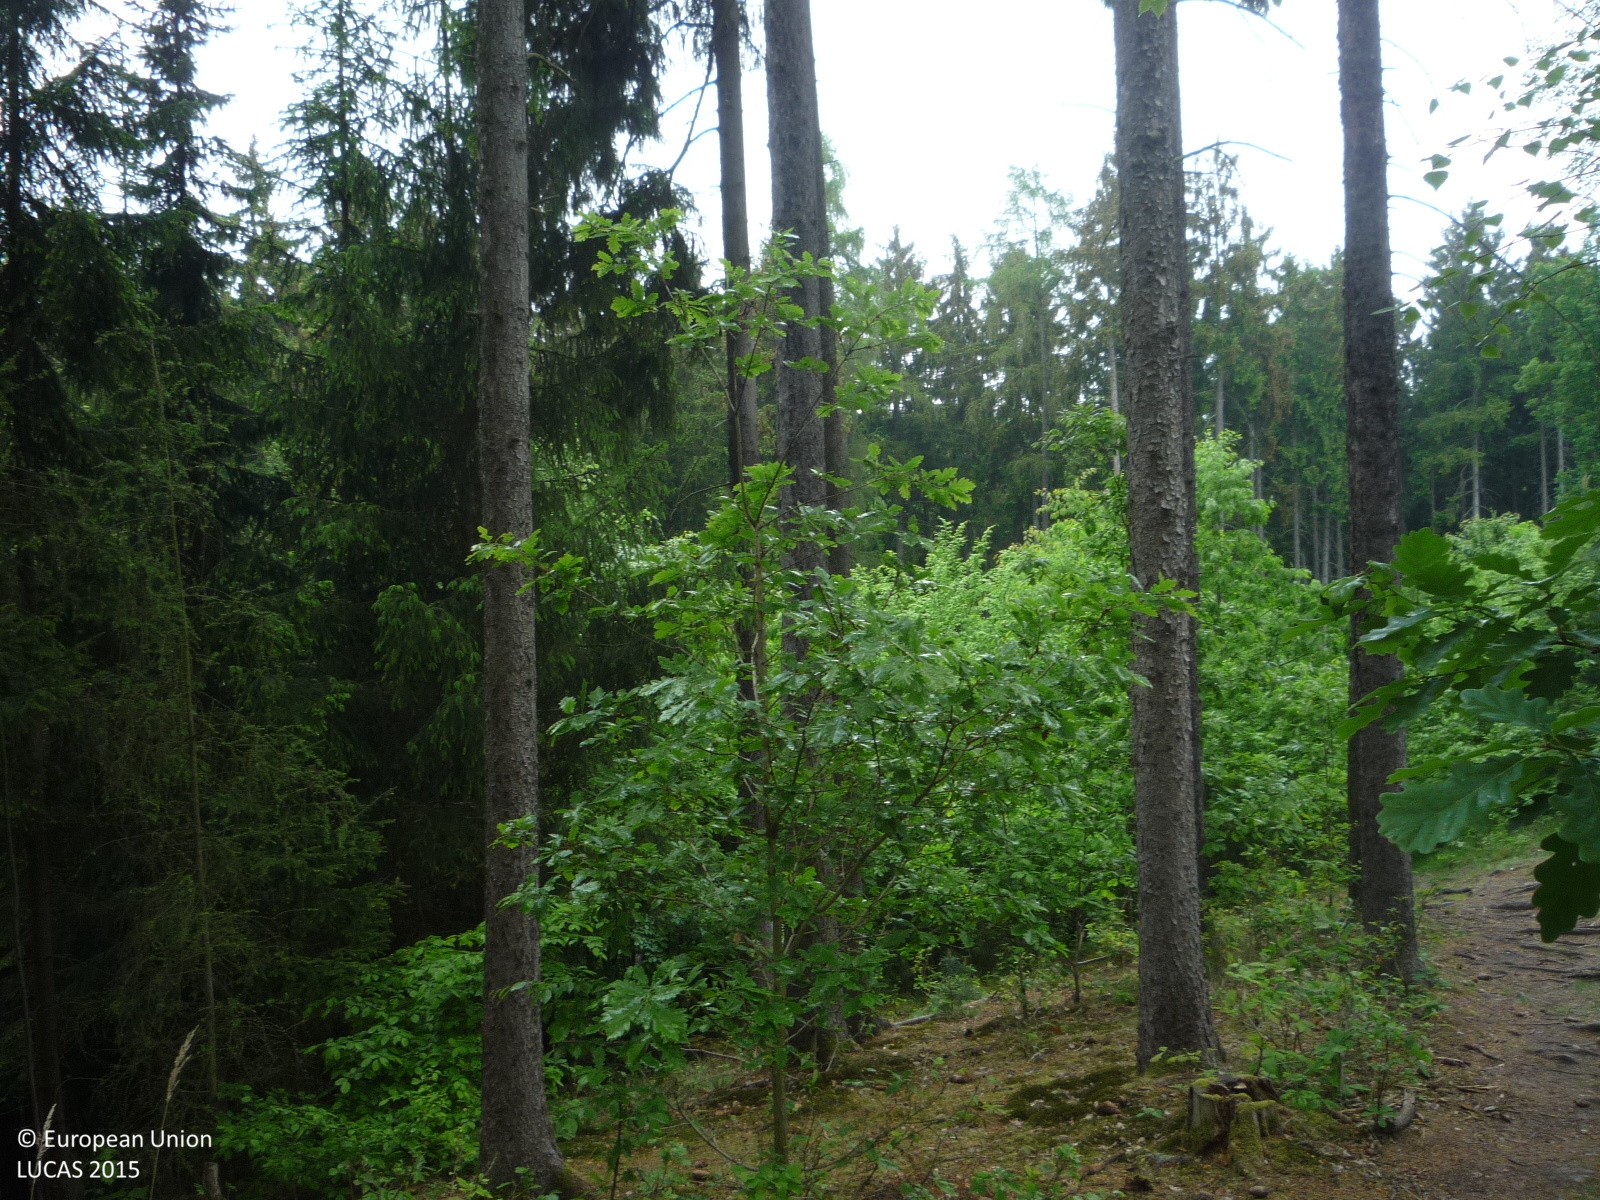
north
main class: Woodland
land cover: Spruce dominated mixed woodland
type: hemiboreal forest and nemoral coniferous forest and mixed broadleaved-coniferous forest
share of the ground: > 75 %
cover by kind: coniferous forest trees 60 %, broadleaved forest trees 30 %, herbaceous plants 5 %, unconsolidated bare surface 5 %
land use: Forestry
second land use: Sport
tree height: > 5 m
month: May
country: CZ
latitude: 50.0241
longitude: 14.4822
